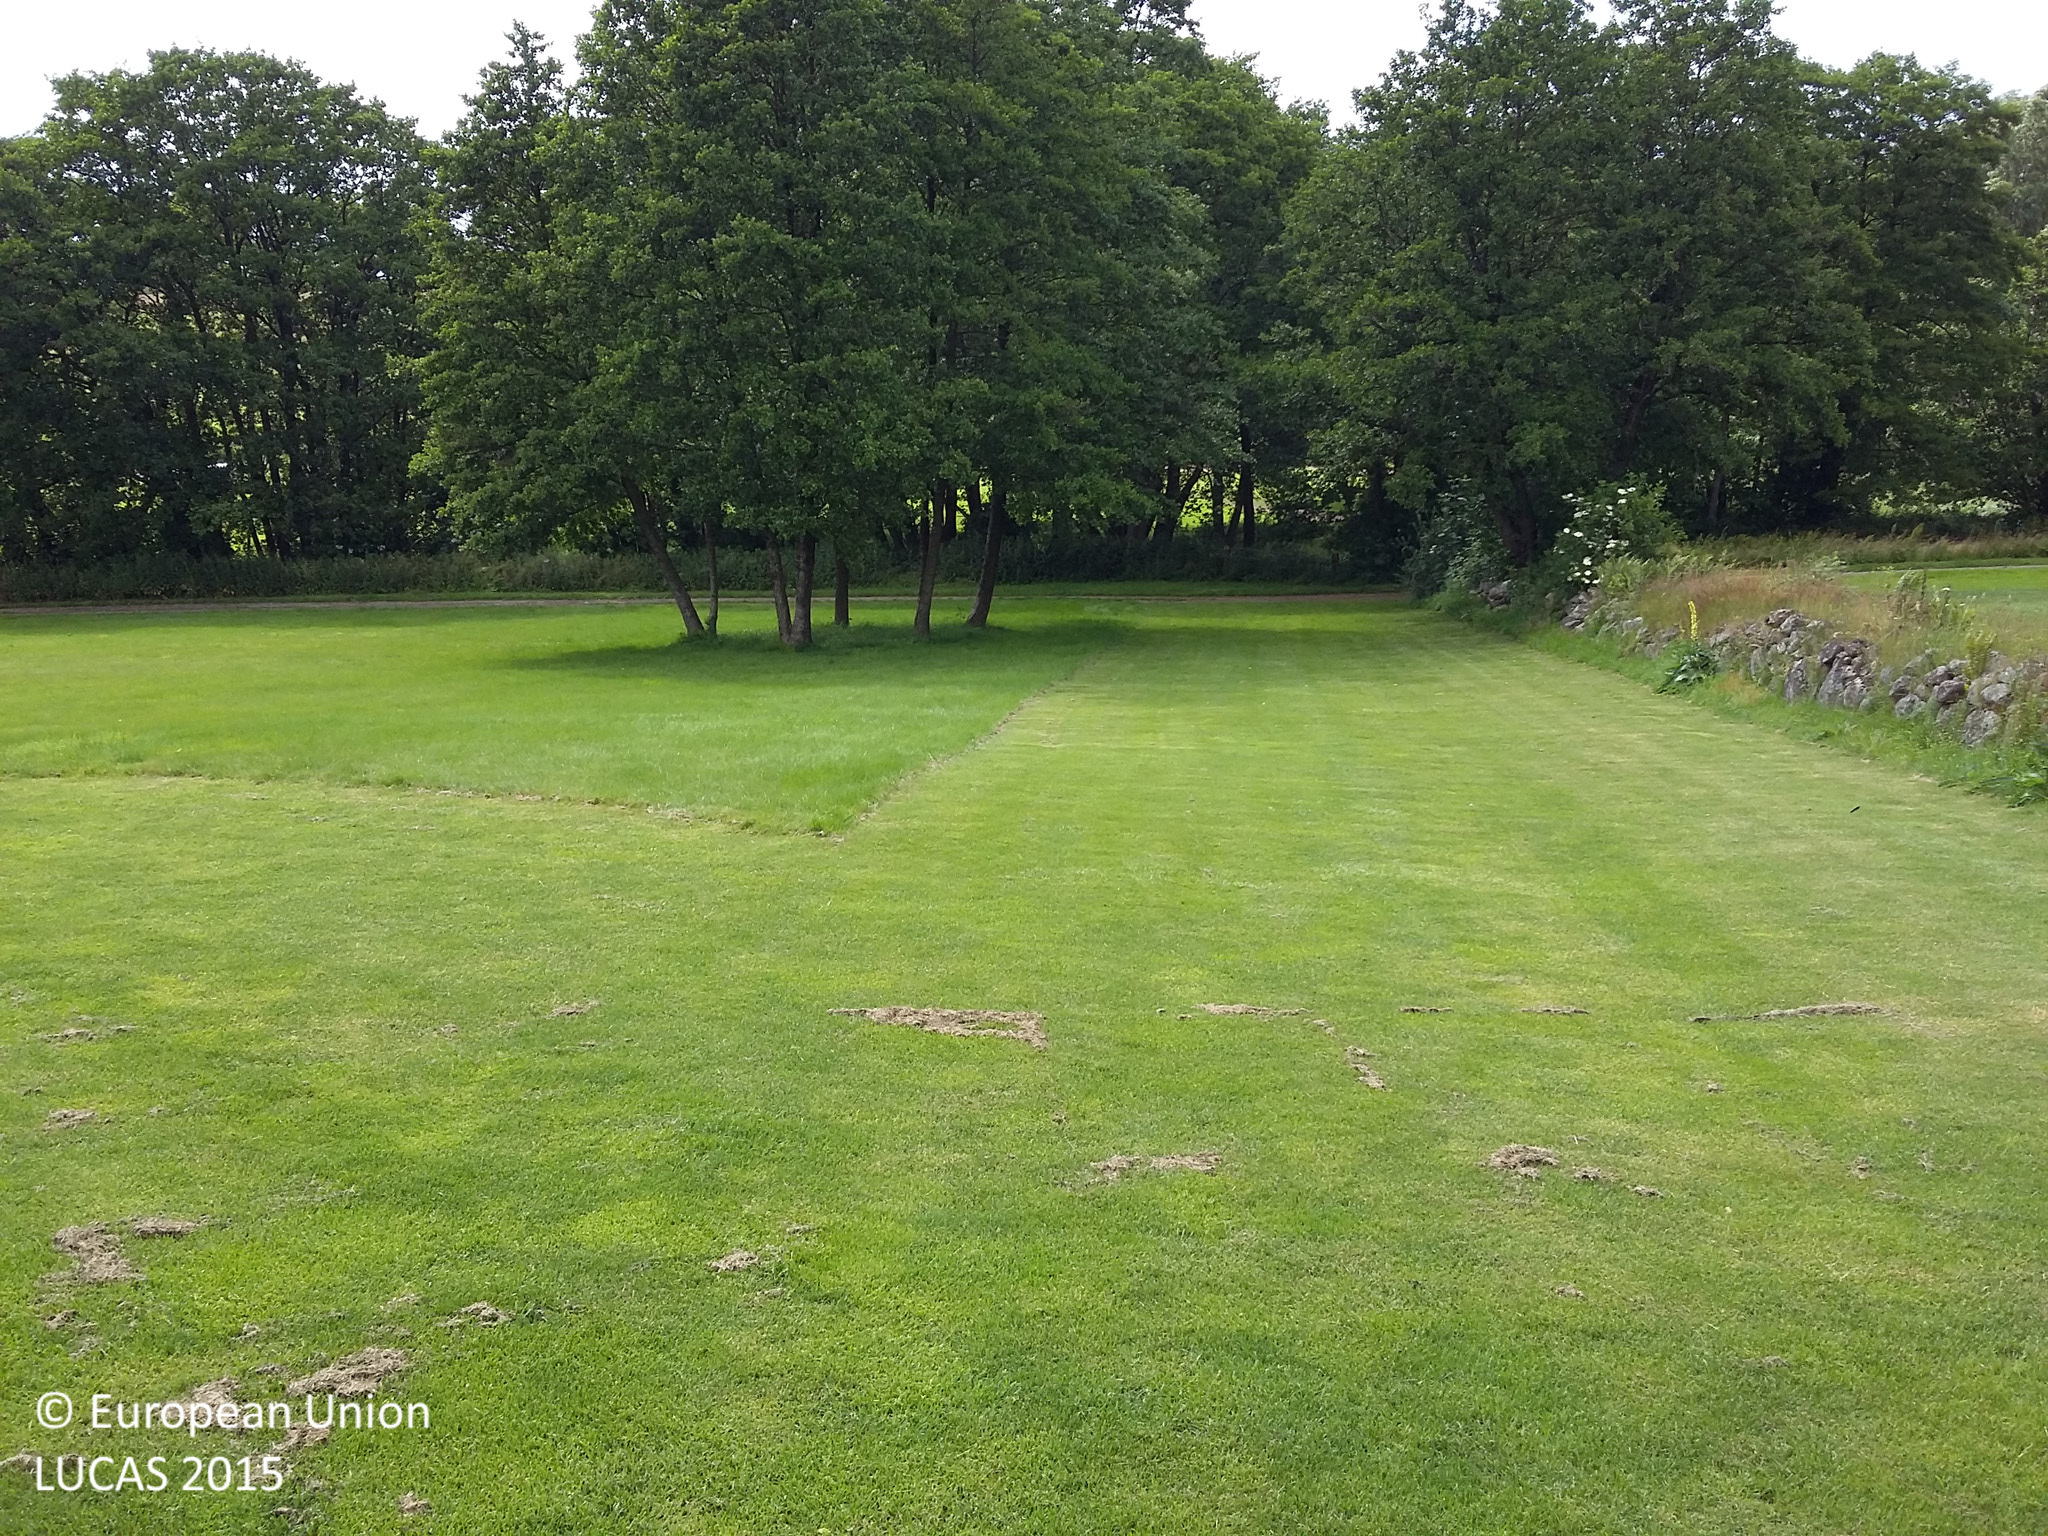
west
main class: Grassland
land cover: Grassland without tree/shrub cover
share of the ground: > 75 %
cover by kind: herbaceous plants 100 %
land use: Sport
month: July
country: DK
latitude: 55.3872
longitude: 11.5615
